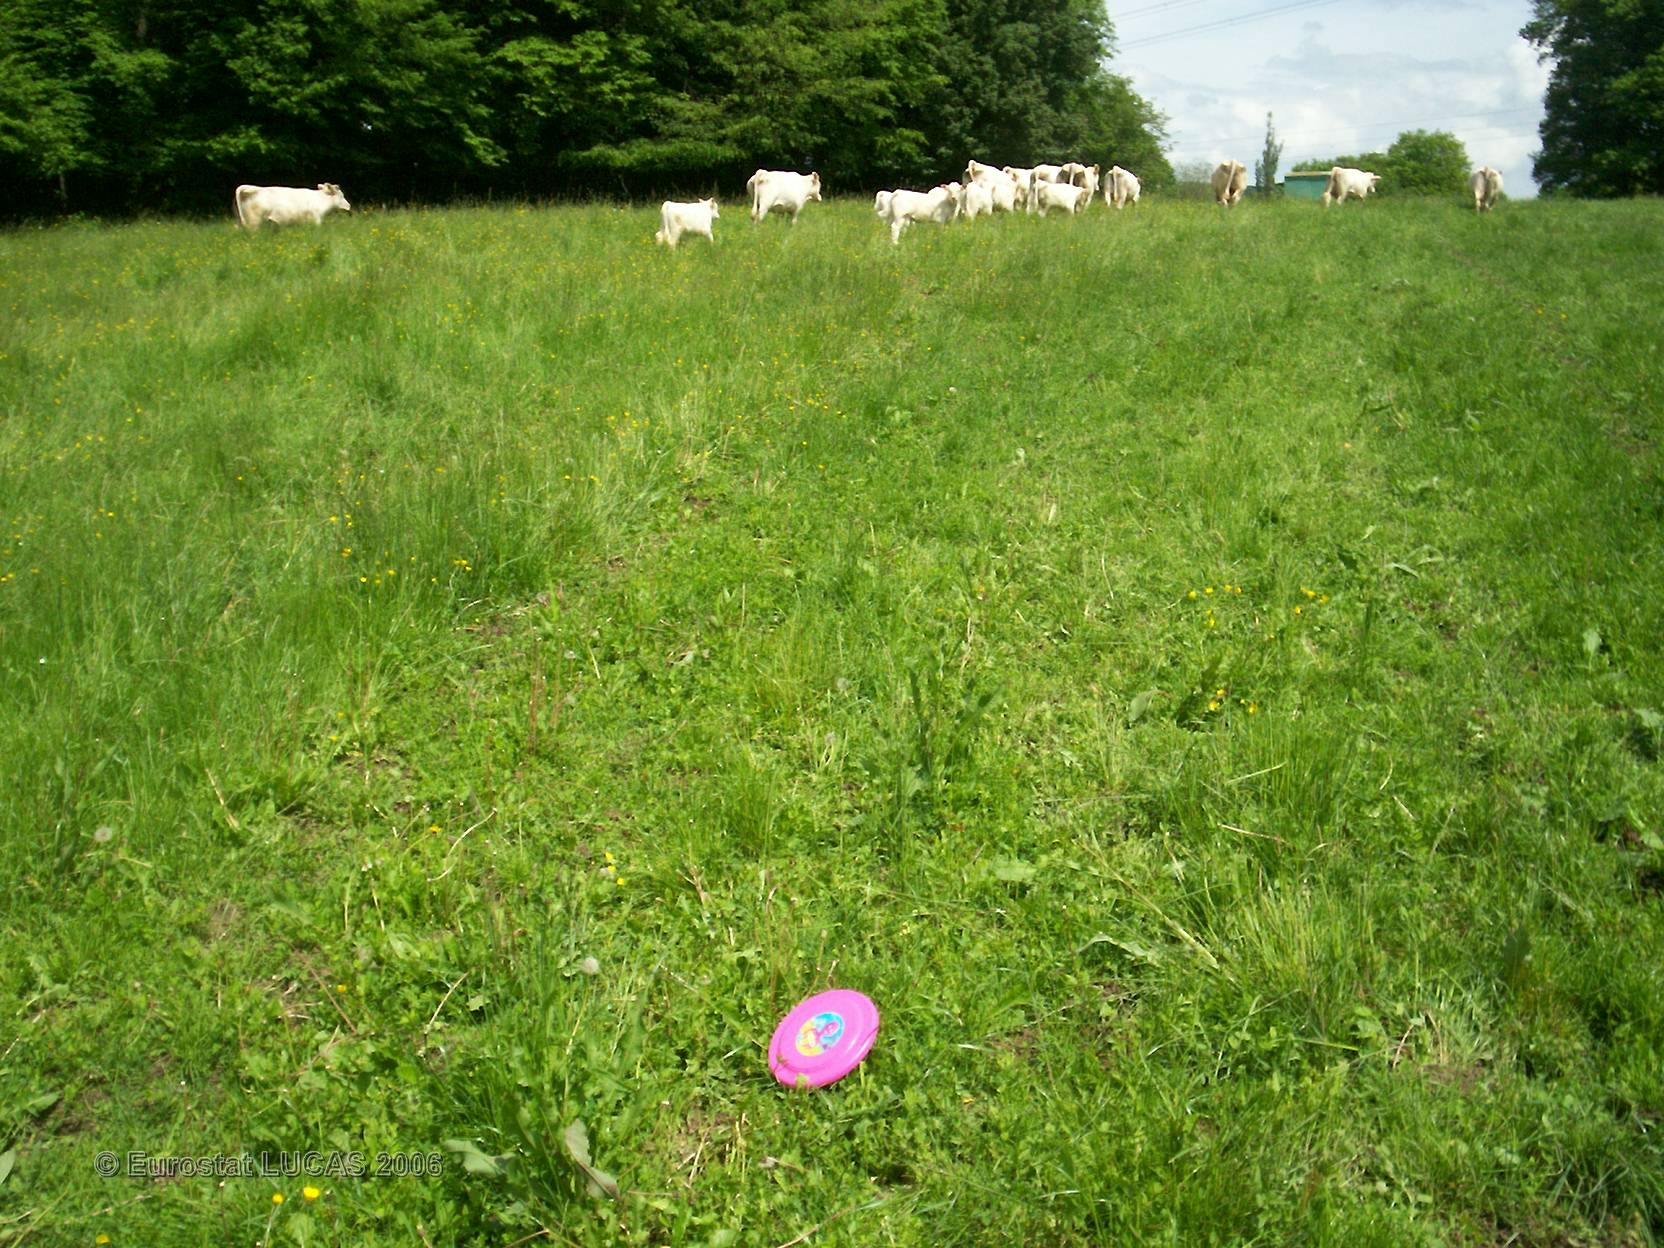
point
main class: Grassland
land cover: Grassland without tree/shrub cover
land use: Agriculture (excluding fallow land and kitchen gardens)
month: May
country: FR
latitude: 46.9907
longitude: 4.5962
